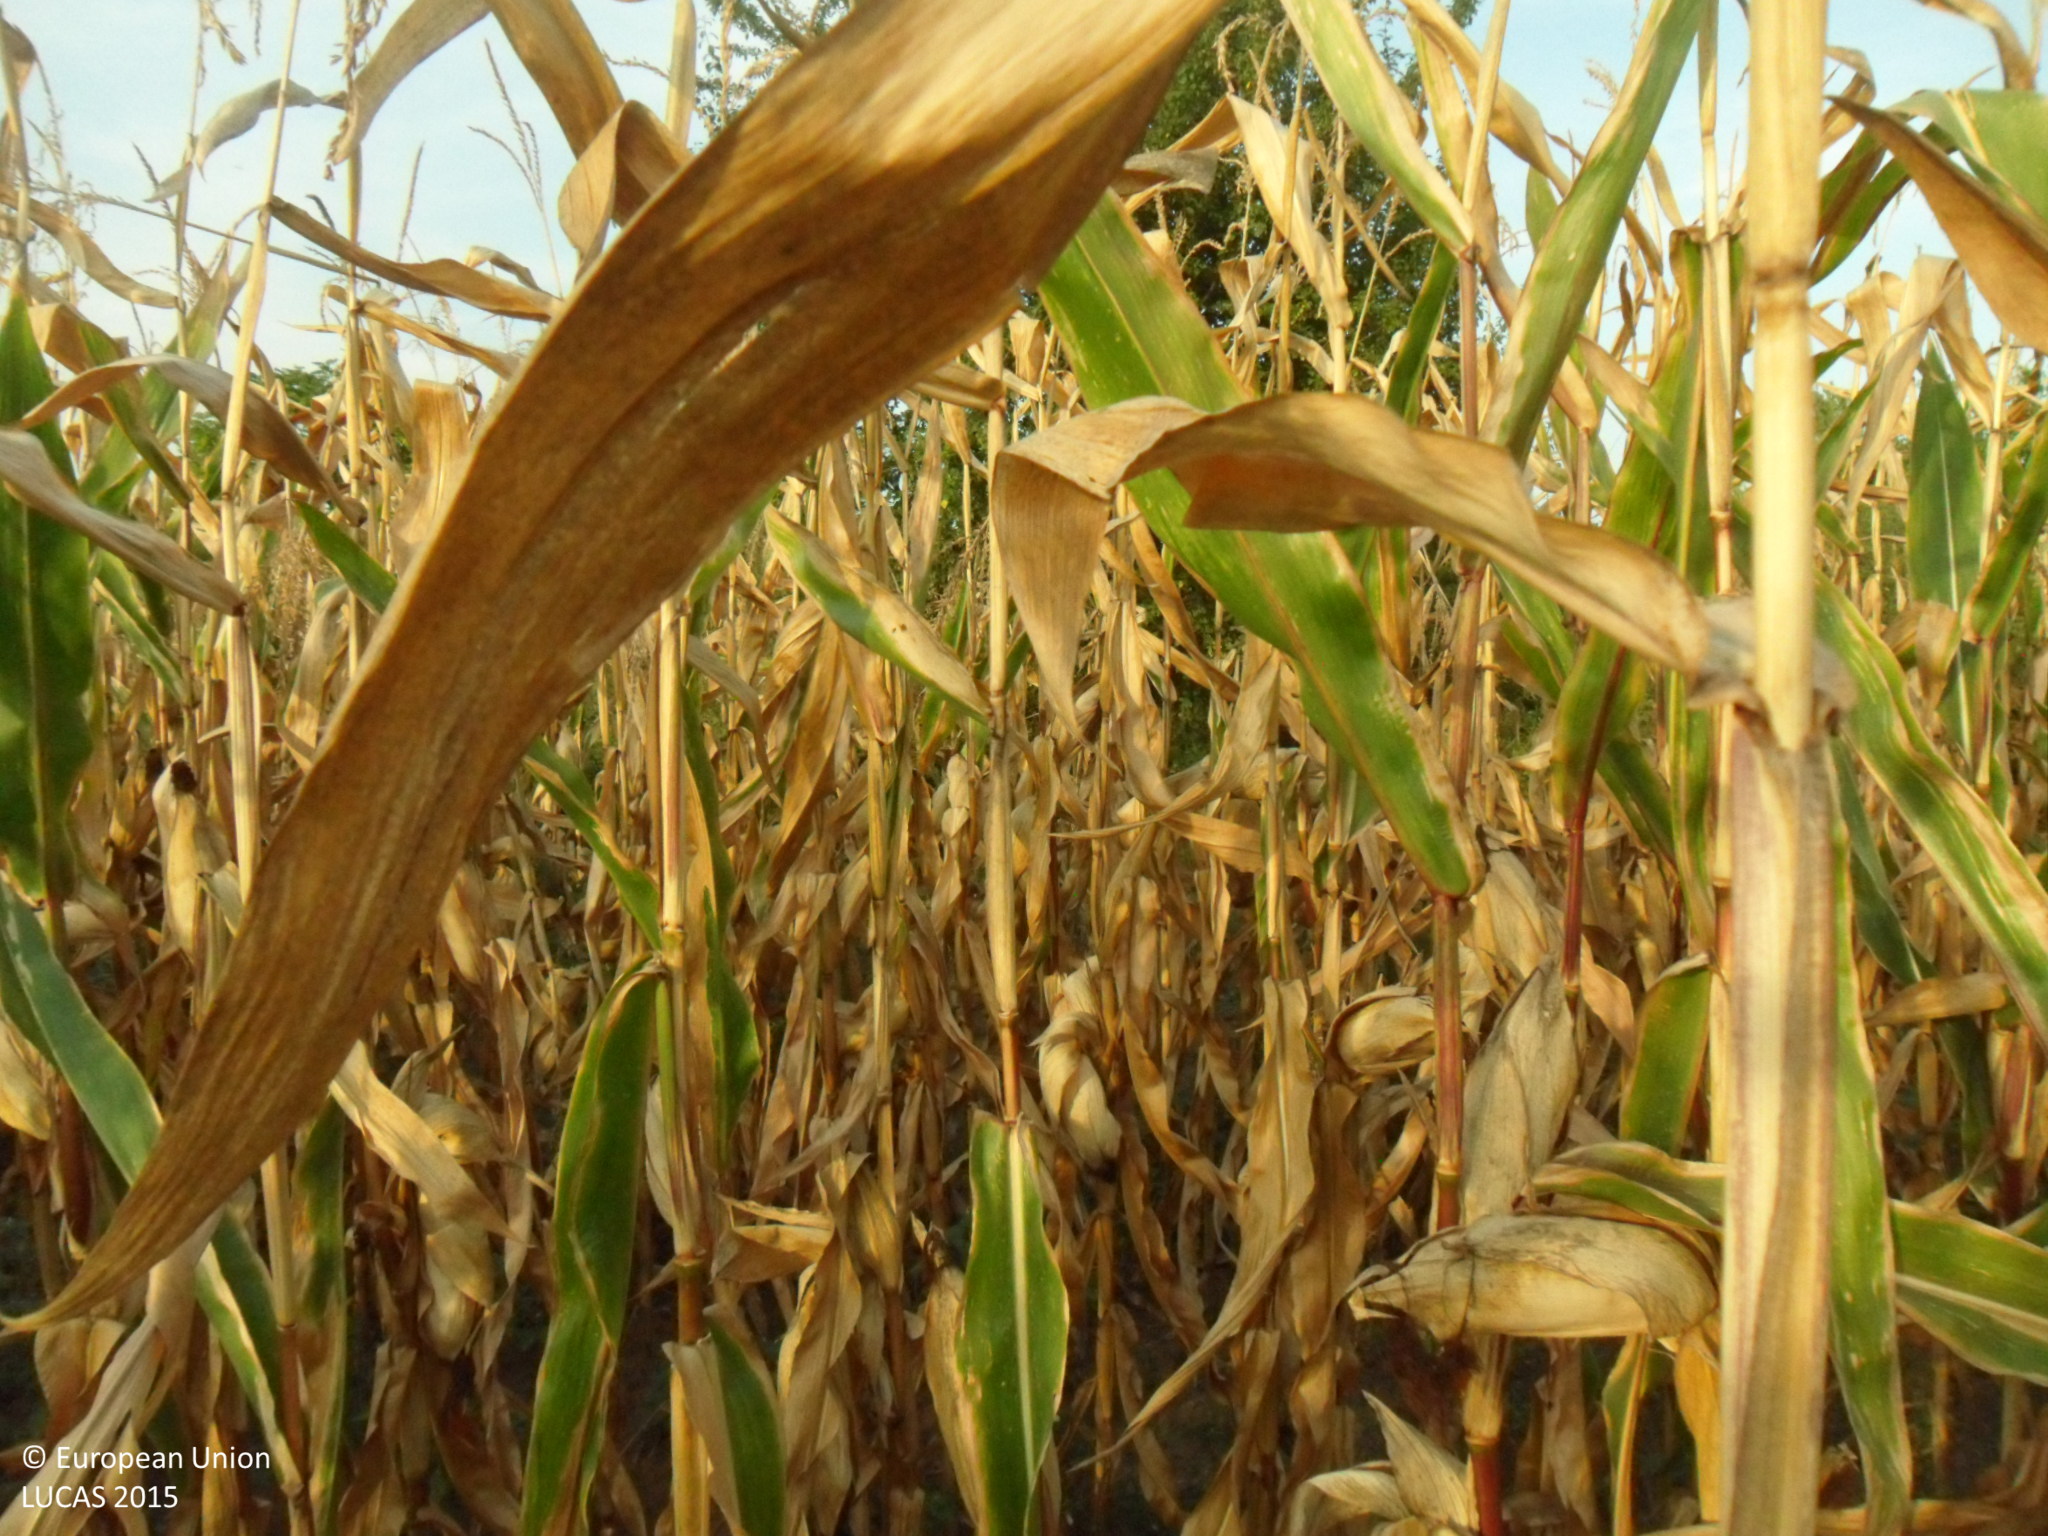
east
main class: Cropland
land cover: Maize
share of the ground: > 75 %
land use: Agriculture (excluding fallow land and kitchen gardens)
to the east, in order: Maize; Grassland with sparse tree/shrub cover; Vineyards; Maize; Grass margins; Vineyards; Tracks; Vineyards; Grassland with sparse tree/shrub cover; Vineyards
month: September
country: BG
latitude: 43.5840
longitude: 26.1856
